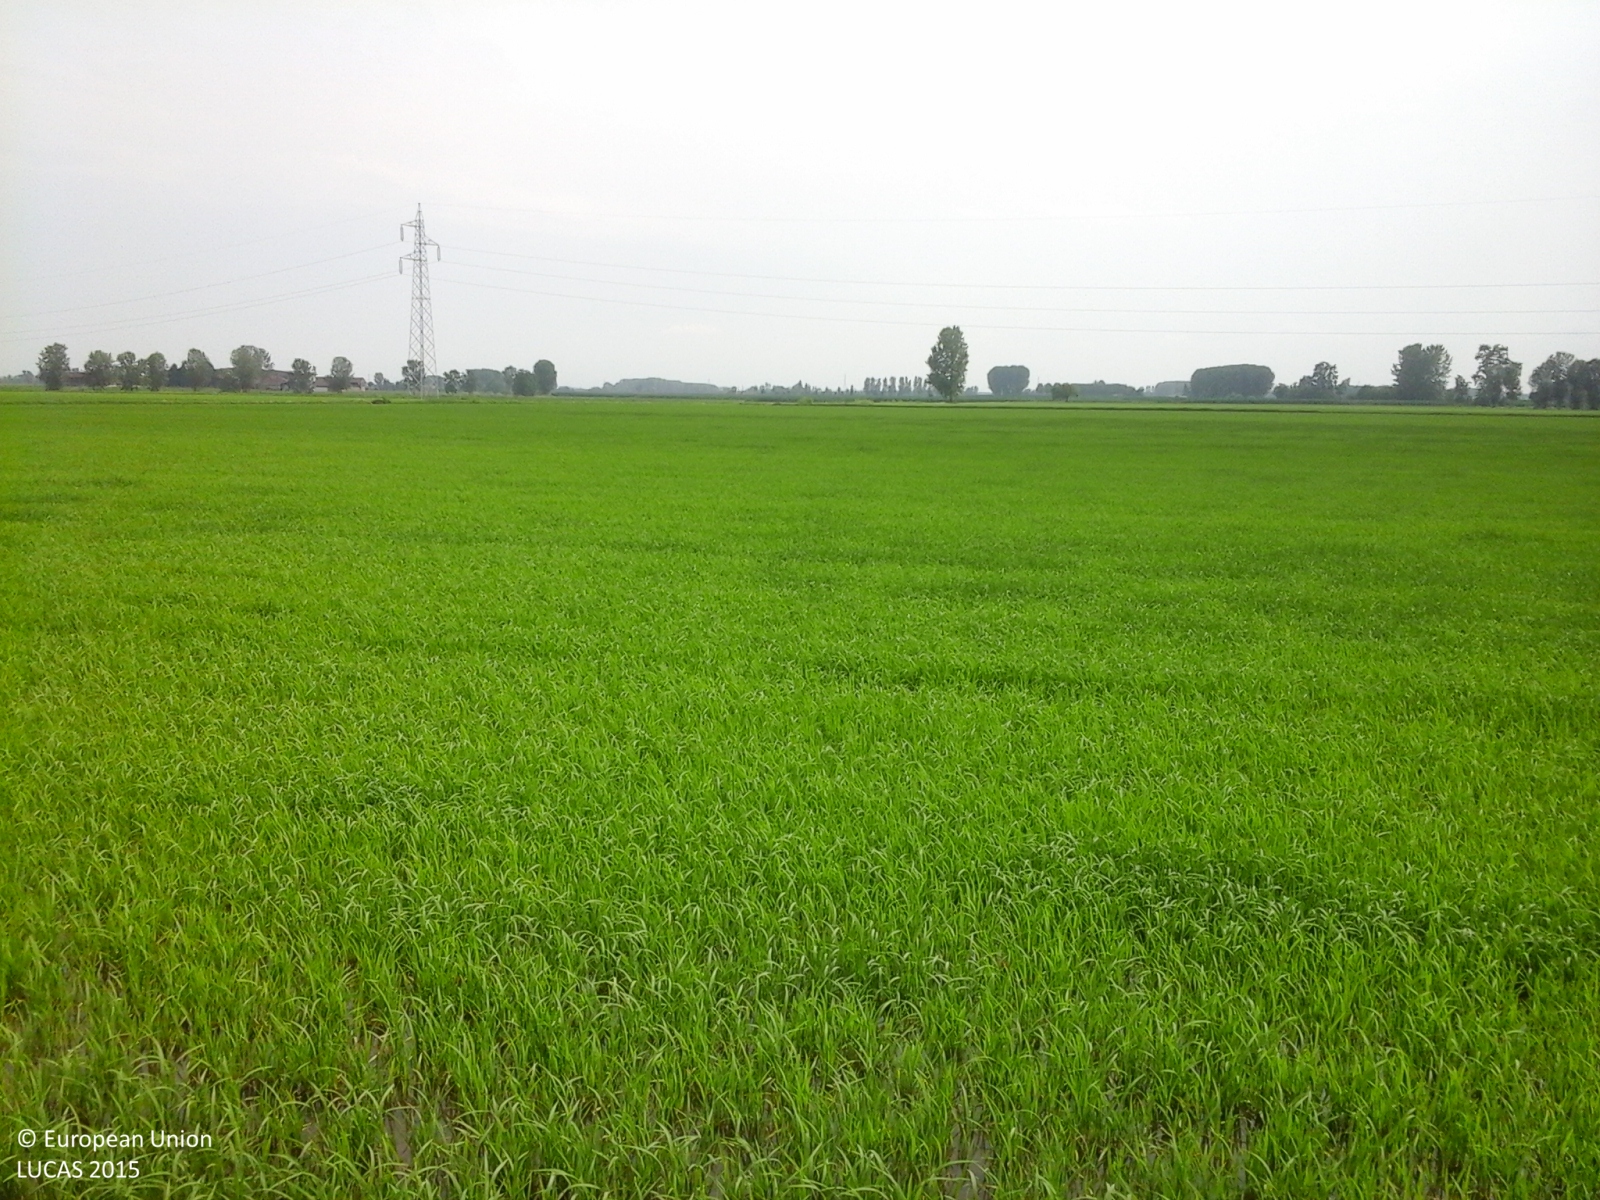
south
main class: Cropland
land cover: Rice
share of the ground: 50 - 75 %
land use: Agriculture (excluding fallow land and kitchen gardens)
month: June
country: IT
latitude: 45.3143
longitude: 8.5611
